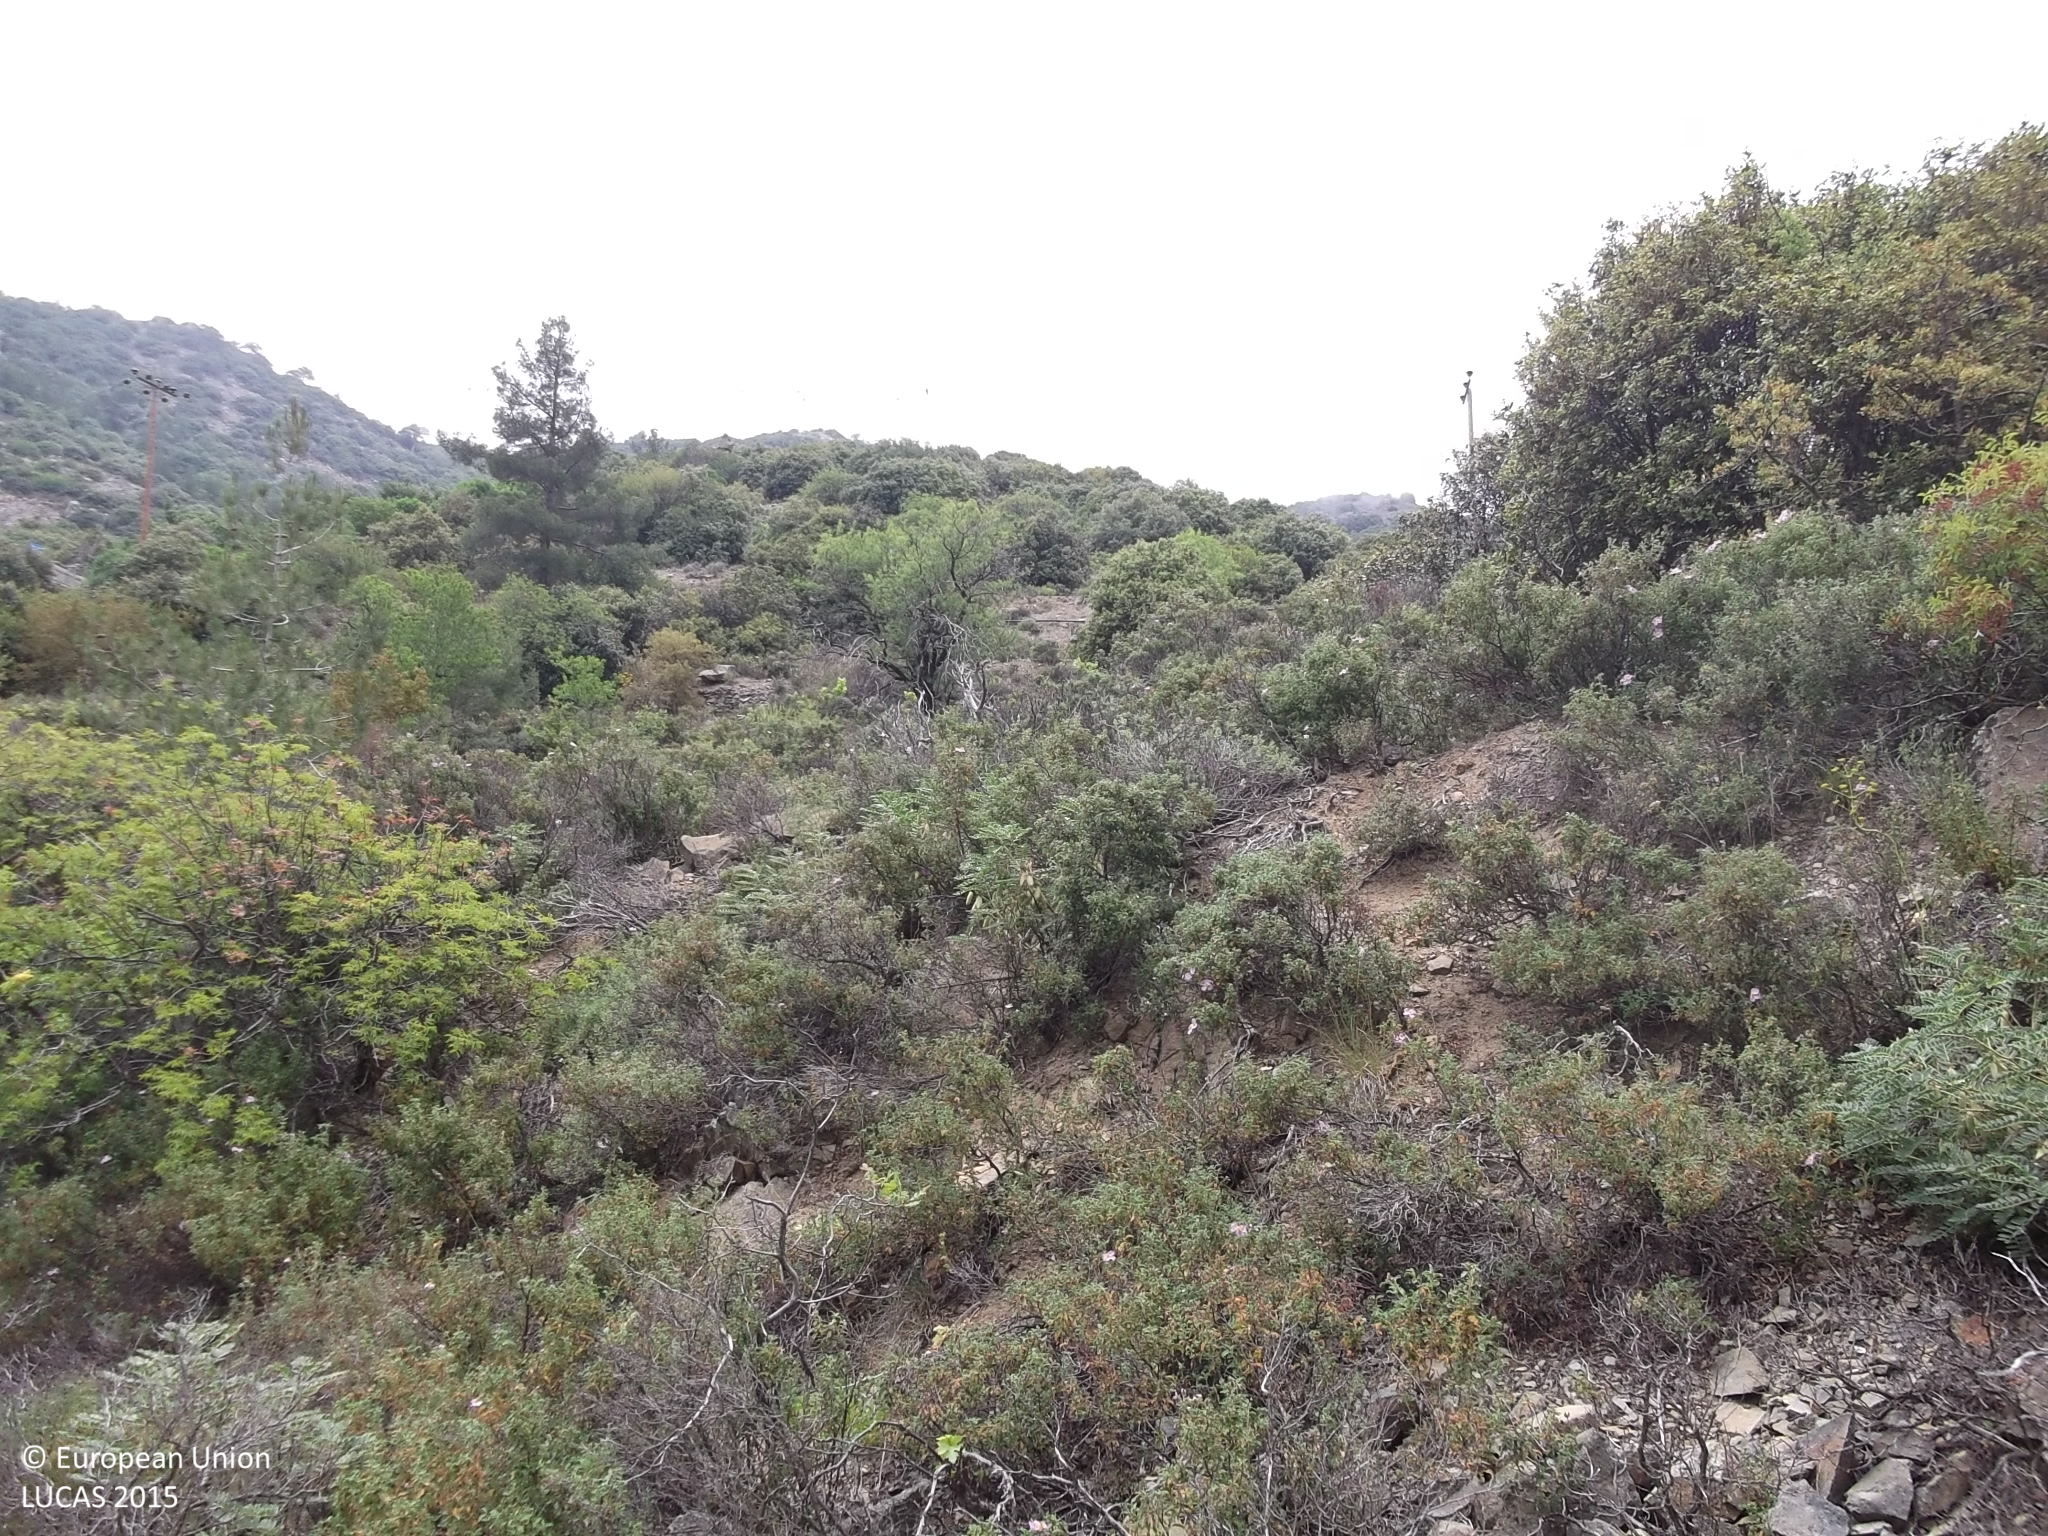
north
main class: Woodland
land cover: Pine dominated mixed woodland
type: coniferous forest of the mediterranean region
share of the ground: 25 - 50 %
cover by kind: coniferous forest trees 40 %, shrubs 35 %, broadleaved forest trees 15 %, unconsolidated bare surface 10 %
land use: Semi-natural and natural areas not in use
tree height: > 5 m
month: June
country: CY
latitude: 34.9490
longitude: 32.9802
